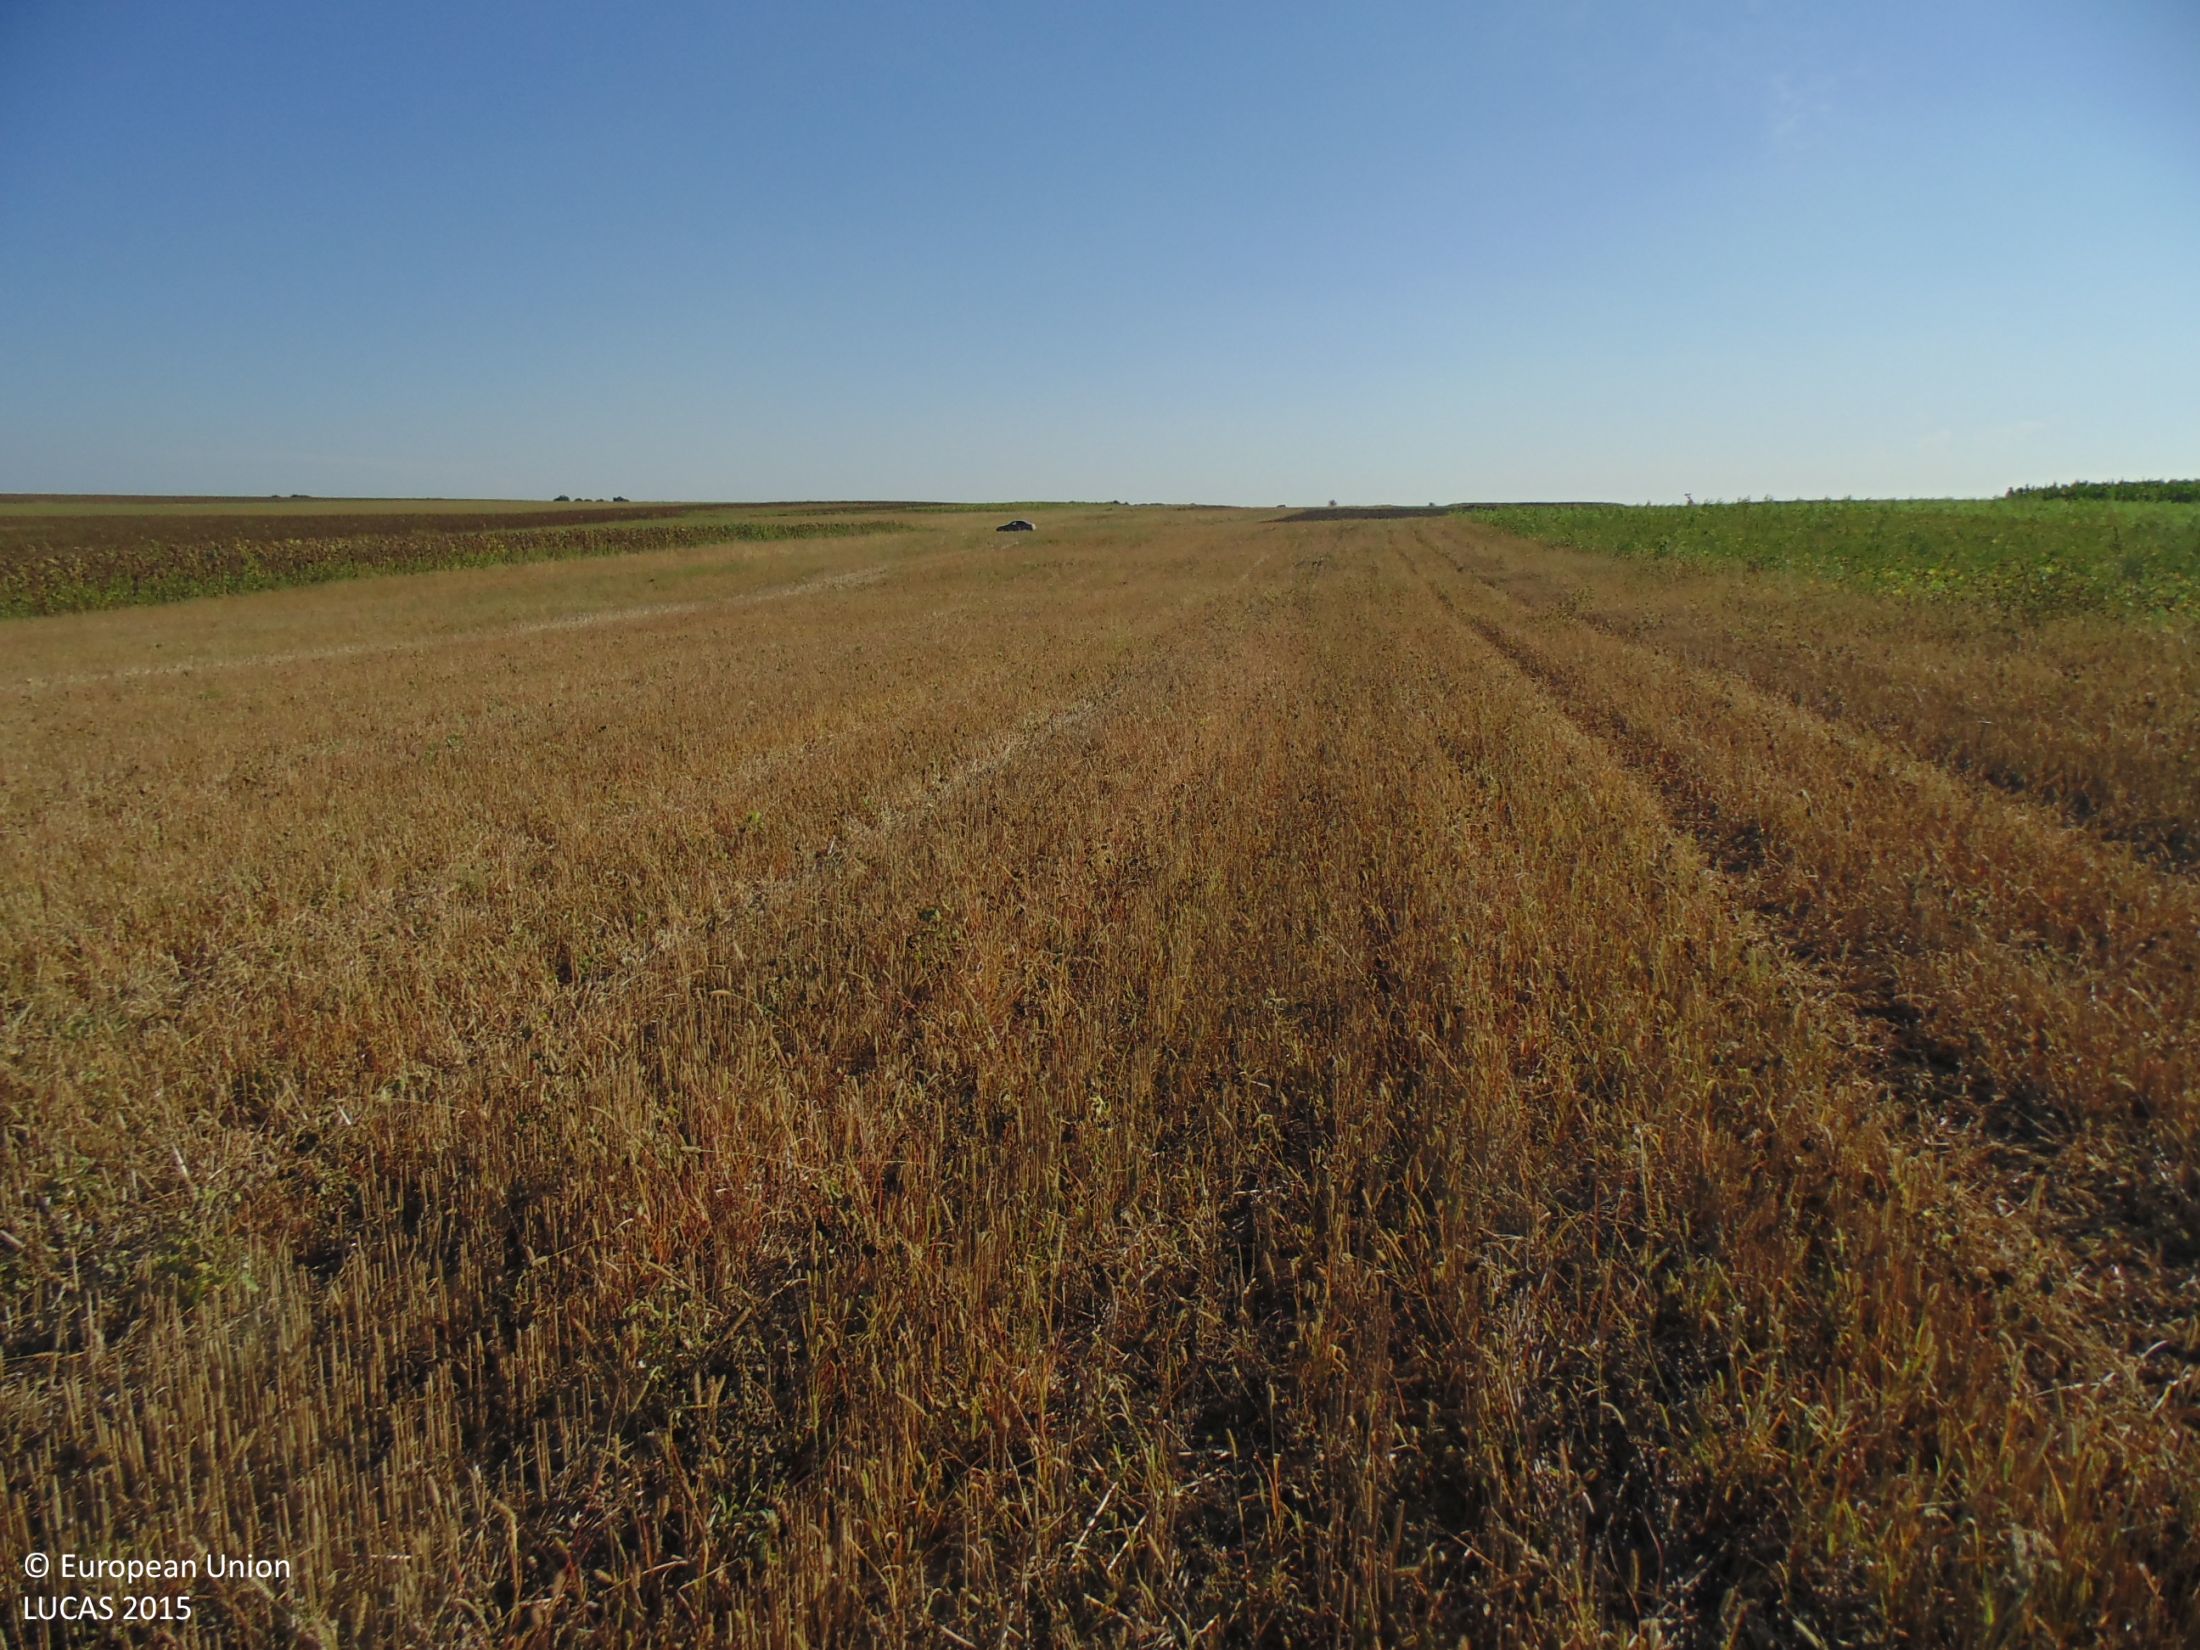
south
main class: Cropland
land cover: Common wheat
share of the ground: 25 - 50 %
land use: Agriculture (excluding fallow land and kitchen gardens)
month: September
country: BG
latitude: 43.8588
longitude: 26.9792
